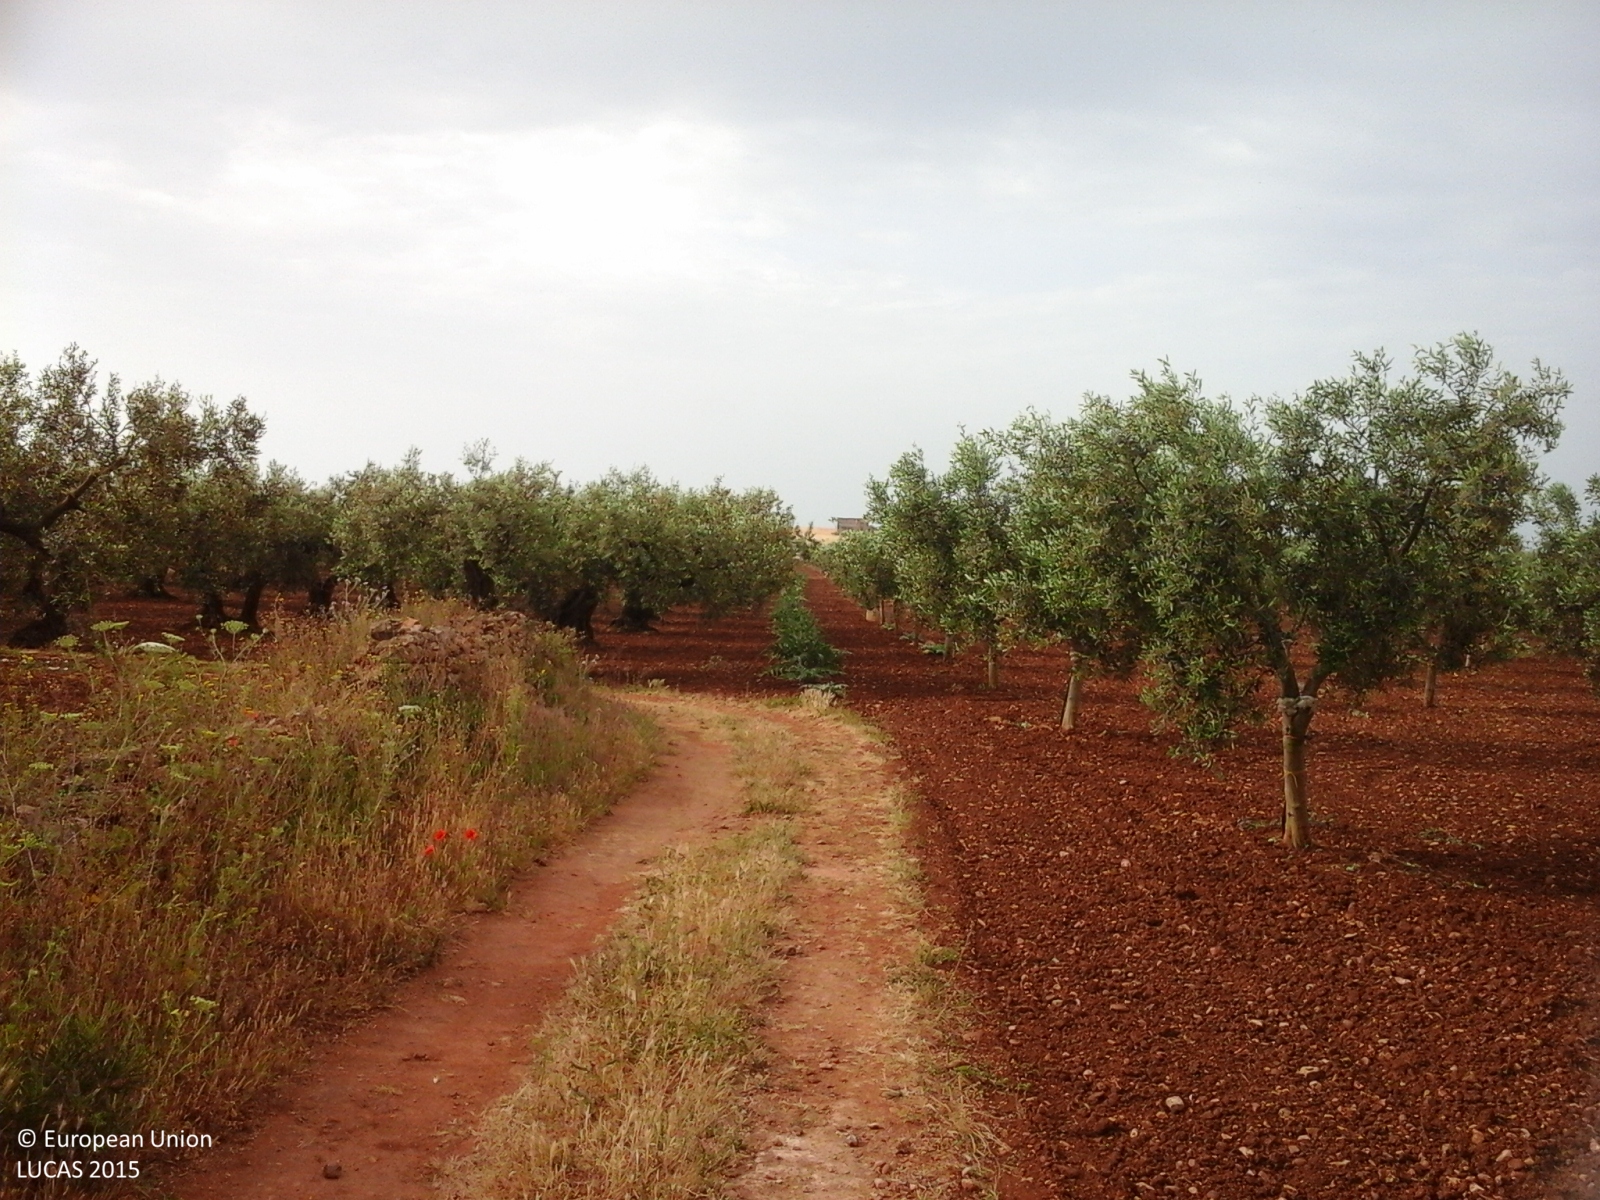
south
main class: Cropland
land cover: Olive groves
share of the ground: 25 - 50 %
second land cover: Other bare soil
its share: > 75 %
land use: Agriculture (excluding fallow land and kitchen gardens)
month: May
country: IT
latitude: 37.5981
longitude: 12.7764
